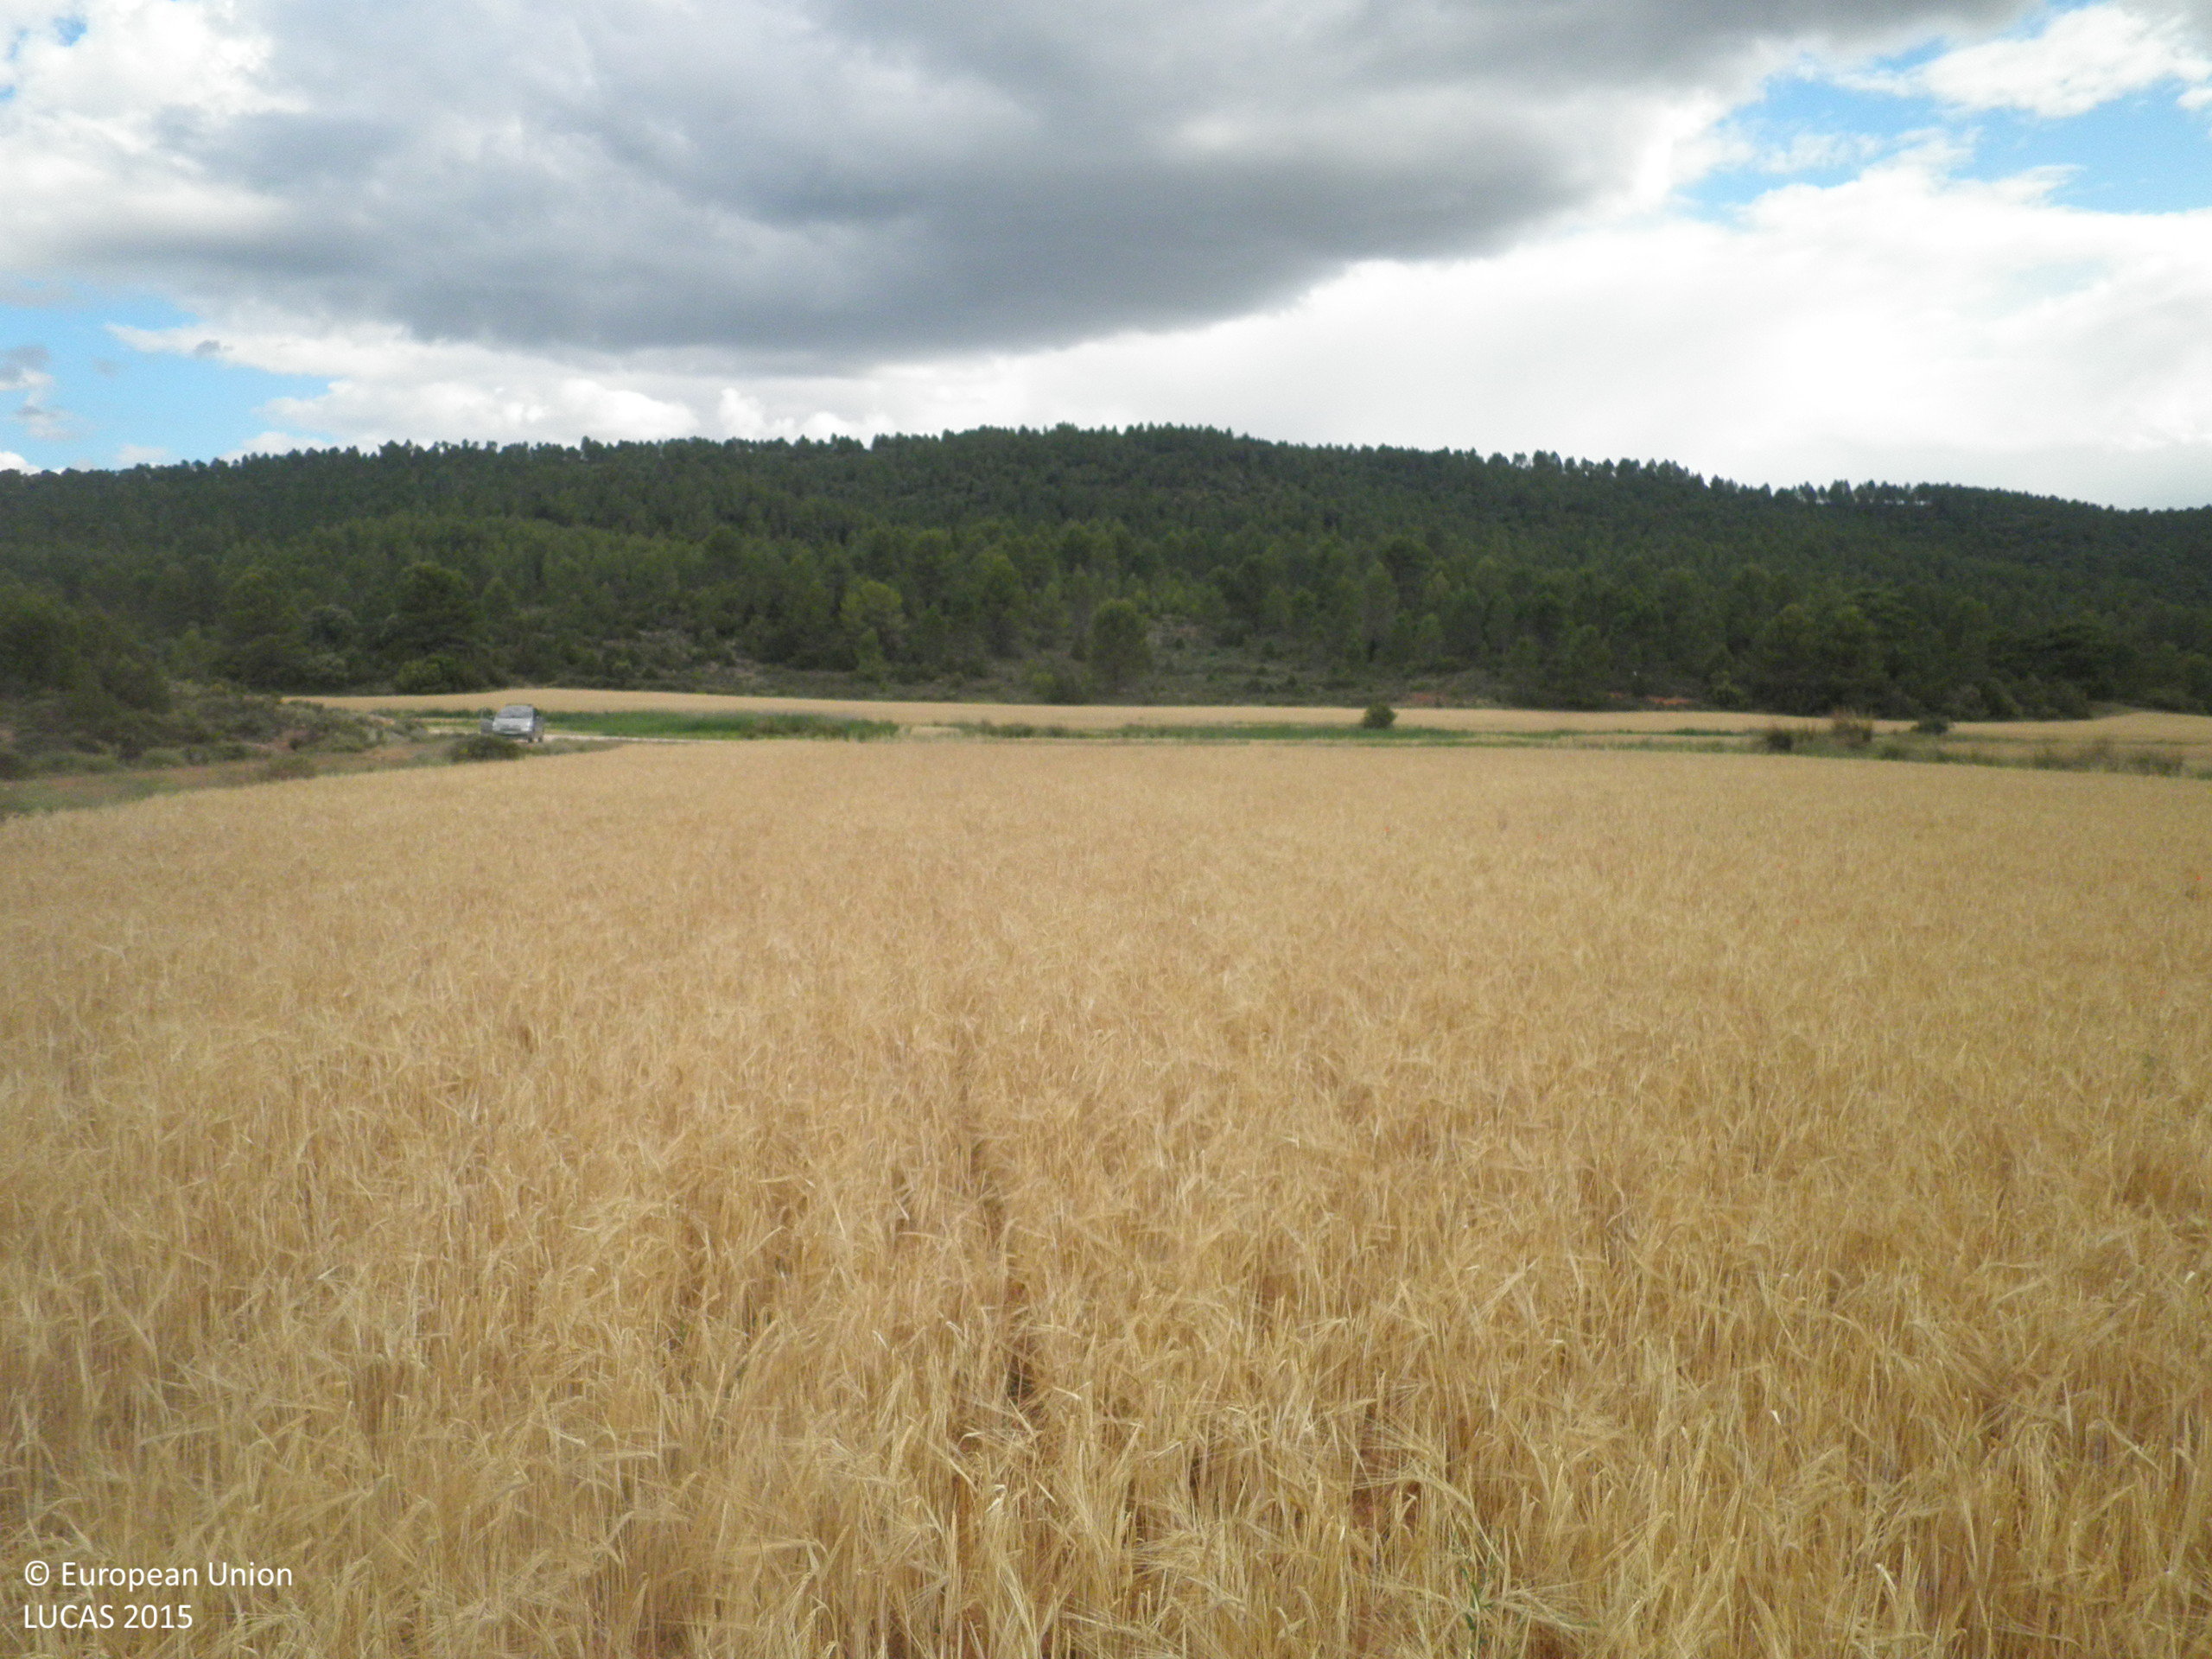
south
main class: Cropland
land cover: Barley
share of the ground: > 75 %
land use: Agriculture (excluding fallow land and kitchen gardens)
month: June
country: ES
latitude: 39.7485
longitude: -1.6906
